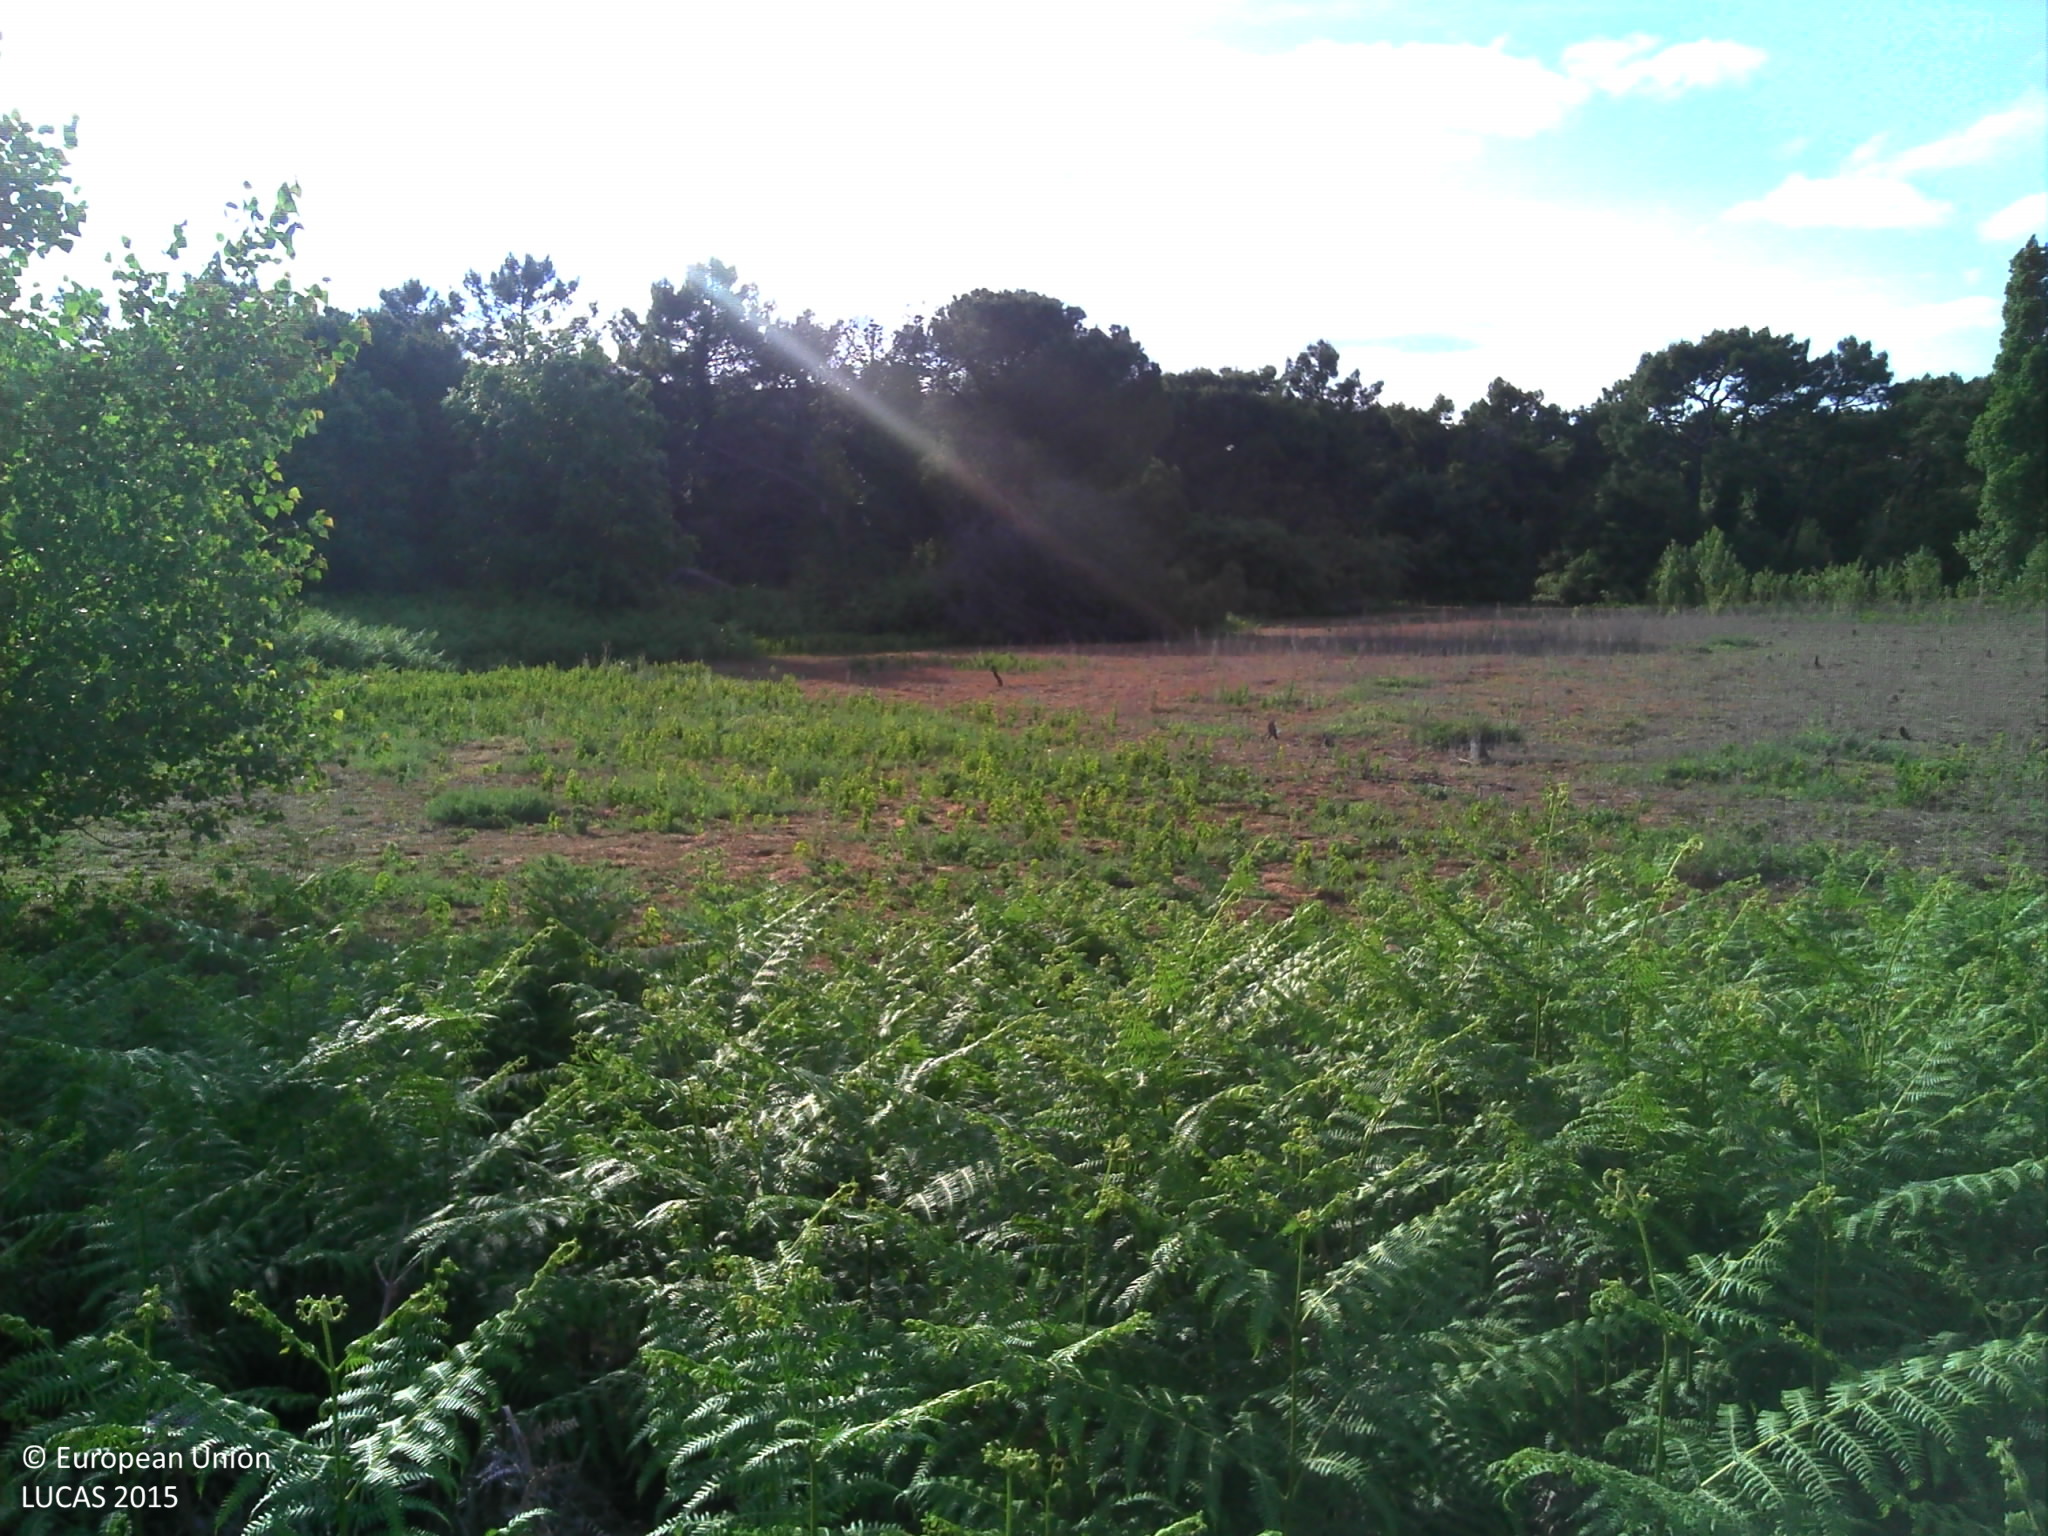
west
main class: Grassland
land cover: Spontaneously vegetated surfaces
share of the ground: > 75 %
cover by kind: herbaceous plants 95 %, shrubs 5 %
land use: Semi-natural and natural areas not in use
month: May
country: FR
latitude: 46.1669
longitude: -1.3145
